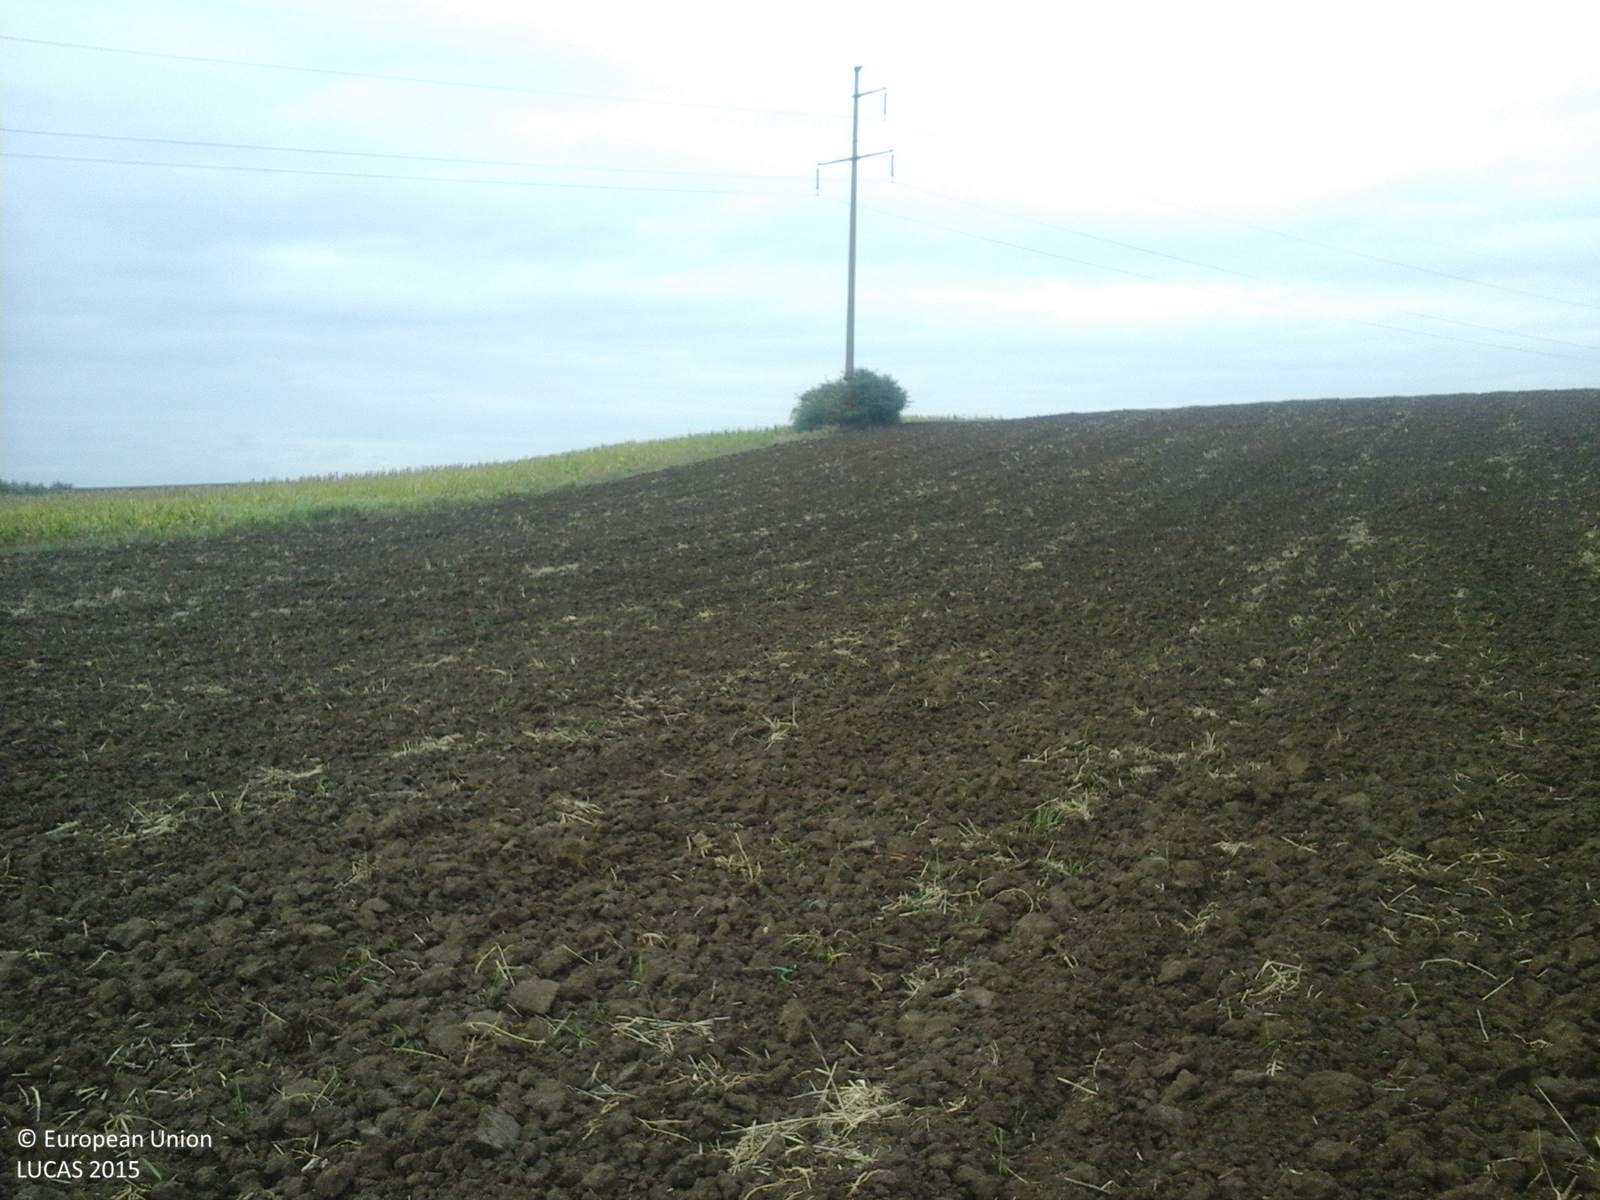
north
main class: Cropland
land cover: Common wheat
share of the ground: < 10 %
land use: Agriculture (excluding fallow land and kitchen gardens)
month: September
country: RO
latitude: 47.1962
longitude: 22.0470
